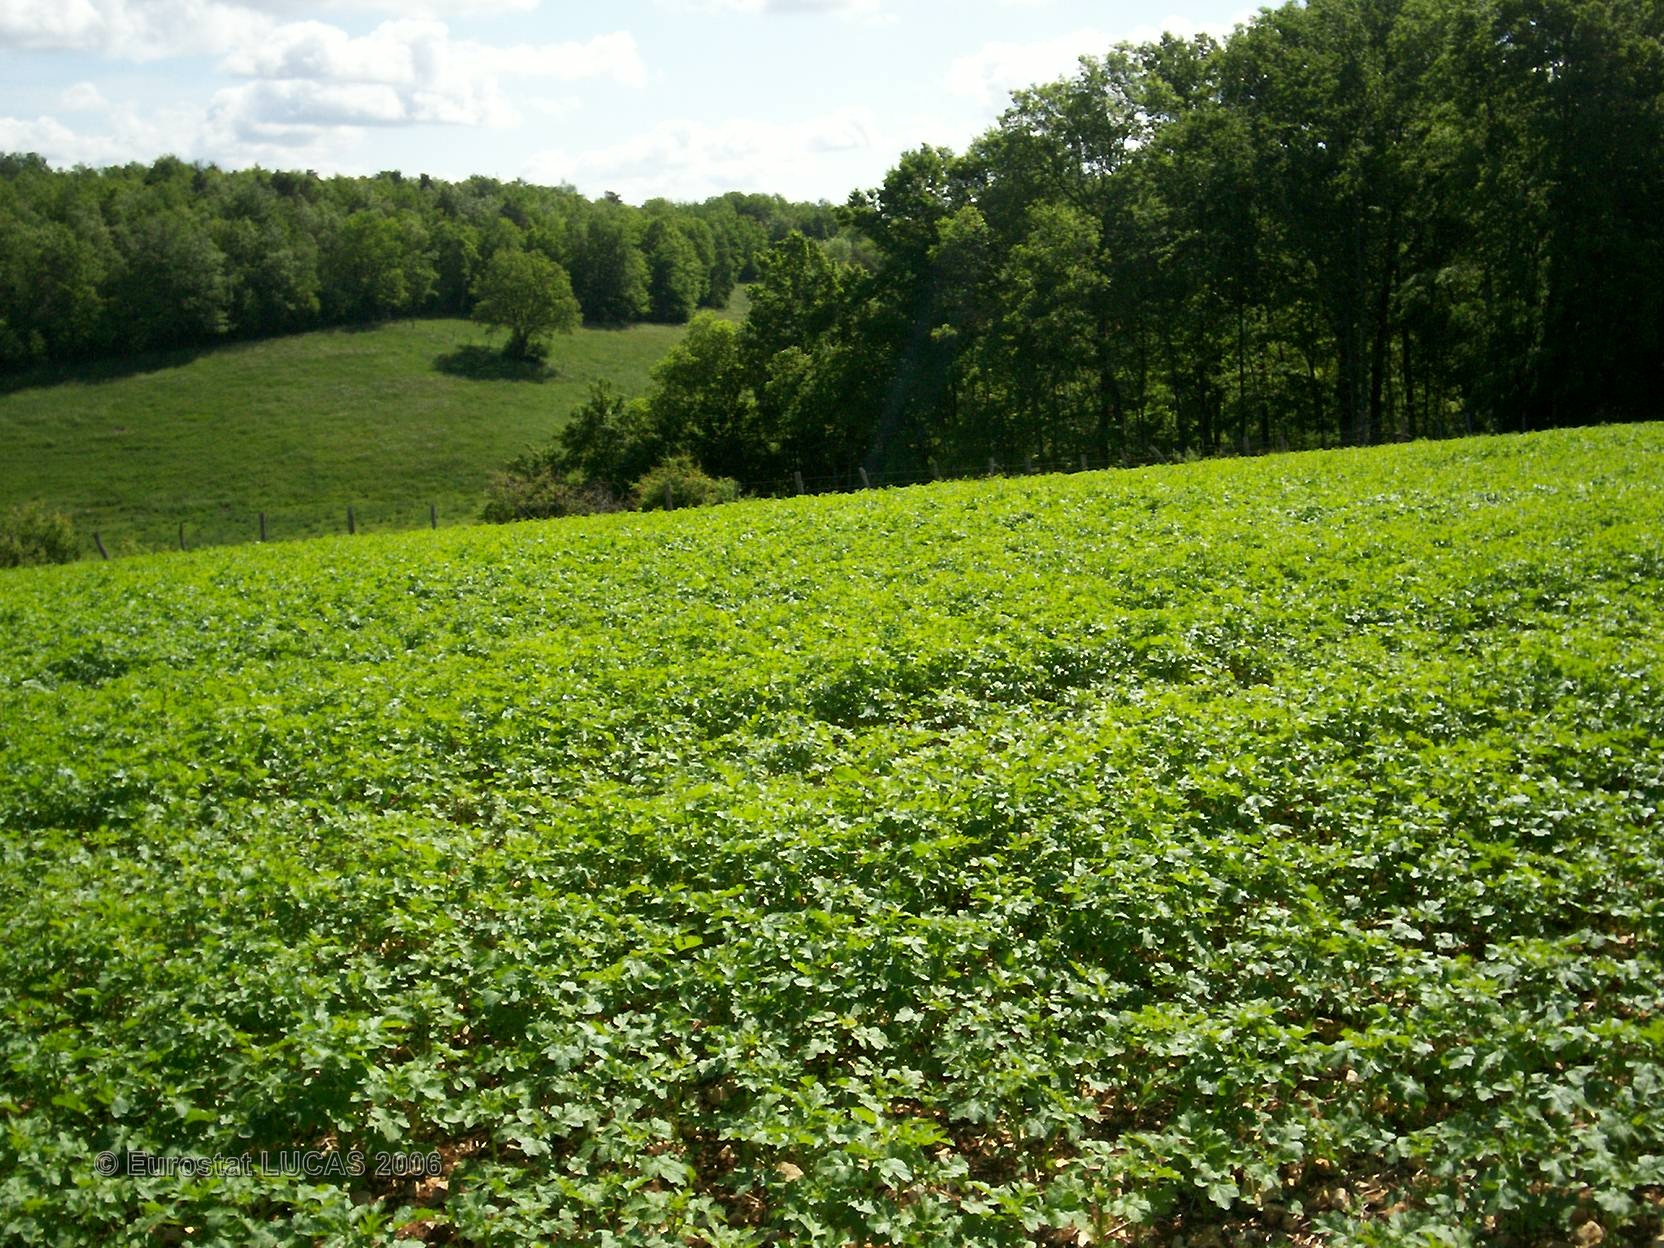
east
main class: Cropland
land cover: Barley
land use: Agriculture (excluding fallow land and kitchen gardens)
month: May
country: FR
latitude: 48.1777
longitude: 4.5242
